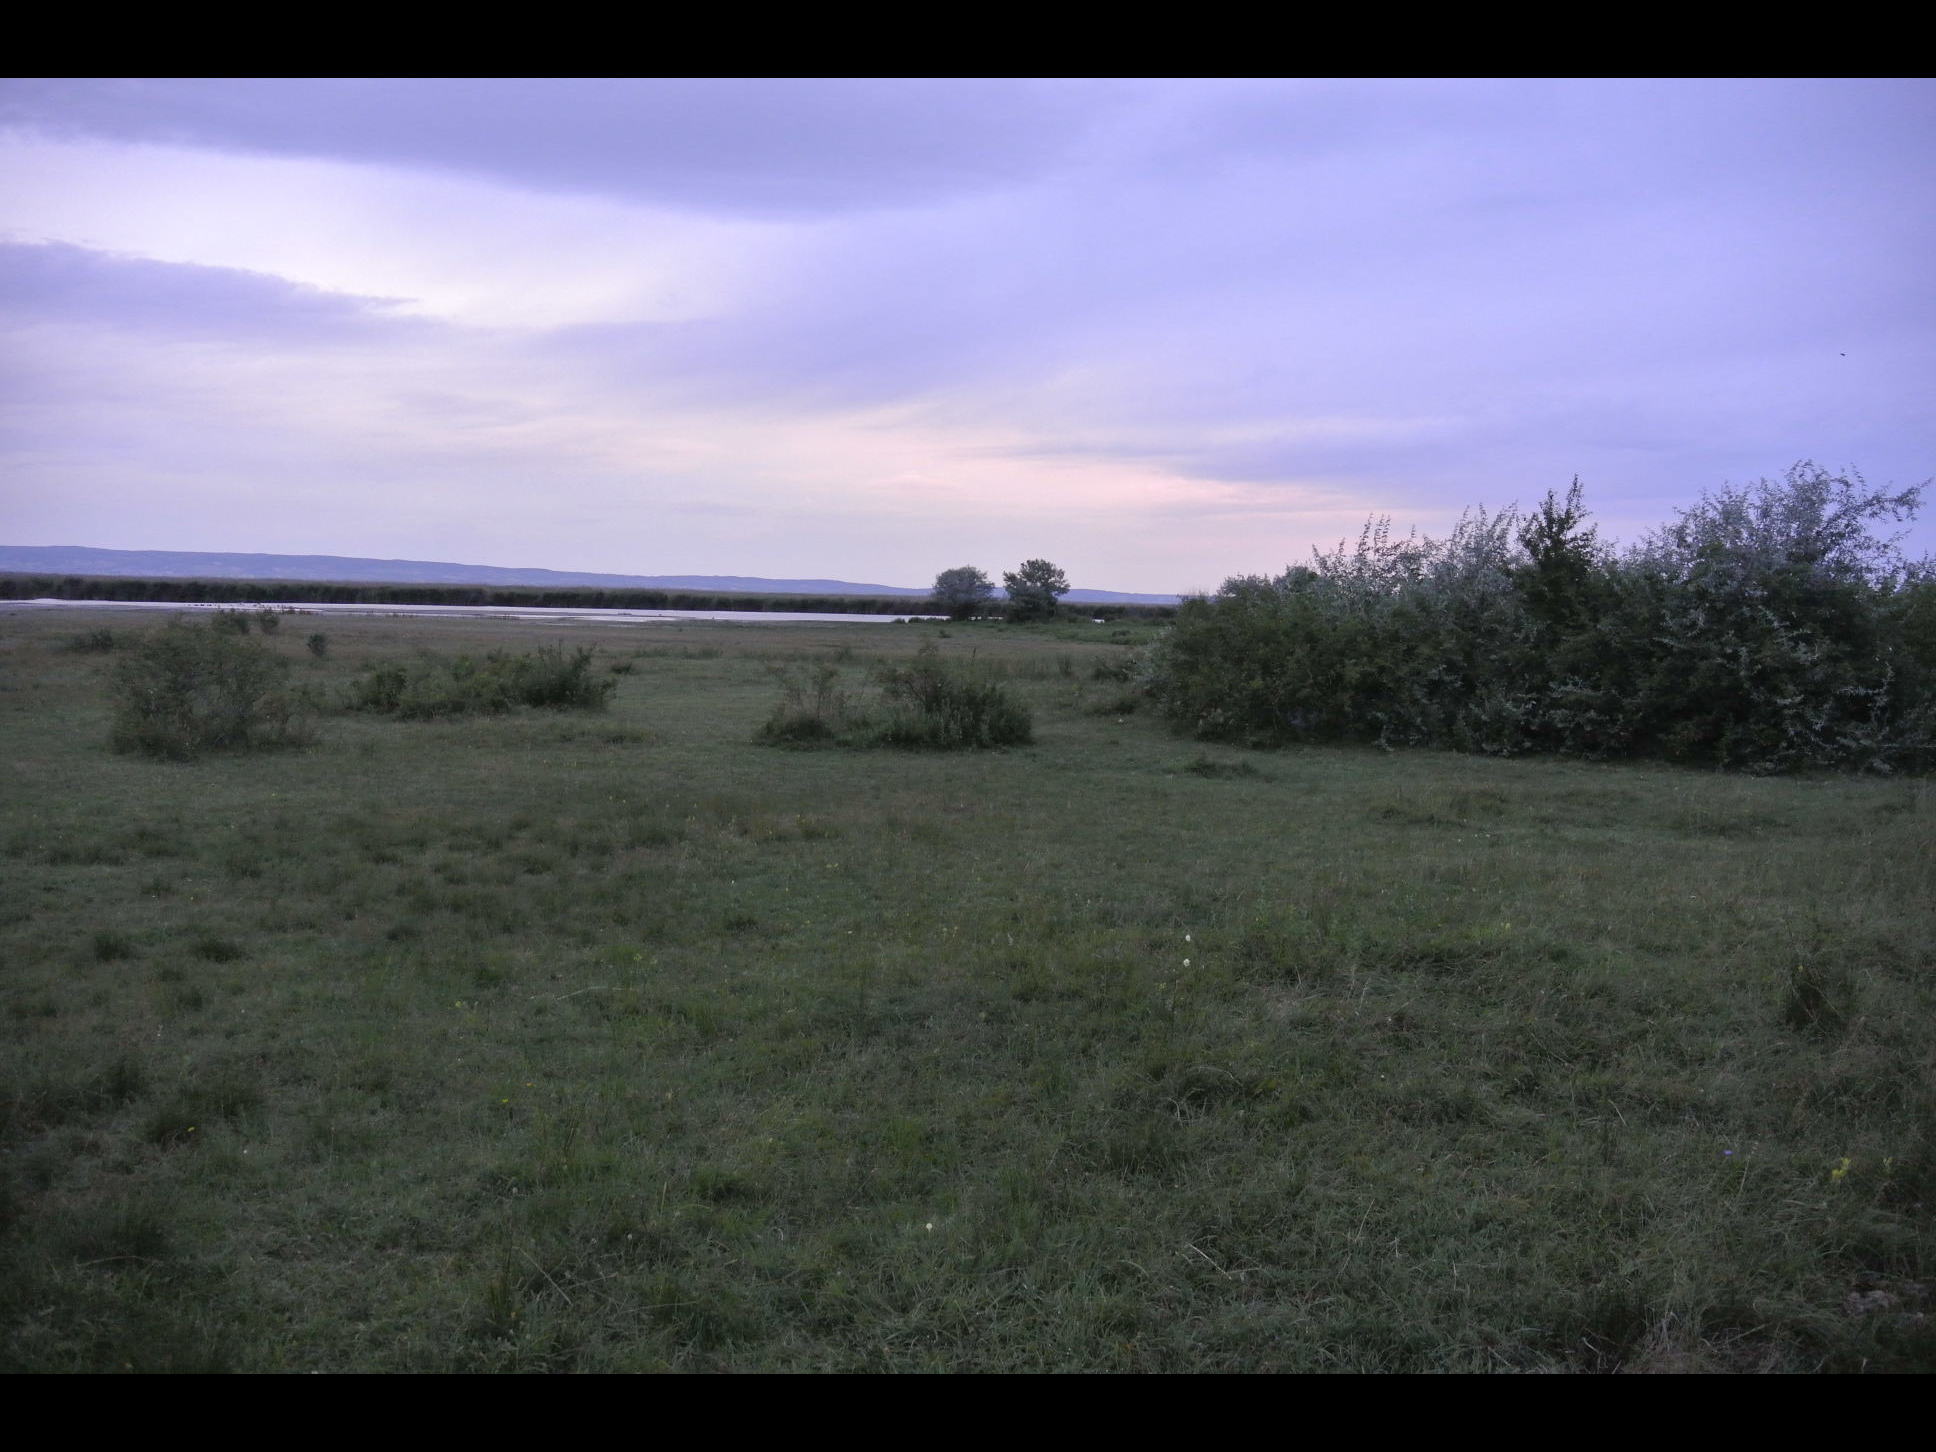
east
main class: Grassland
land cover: Grassland with sparse tree/shrub cover
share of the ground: > 75 %
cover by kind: herbaceous plants 90 %, broadleaved forest trees 5 %, shrubs 5 %
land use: Semi-natural and natural areas not in use
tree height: < 5 m
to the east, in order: Grassland with sparse tree/shrub cover; Fences; Grass margins; Paved roads, cycling and walking lanes; Lines of trees; Tracks; Grassland without tree/shrub cover; Abandoned hedges; Grassland without tree/shrub cover; Inland marshes
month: July
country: AT
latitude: 47.8326
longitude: 16.8058
